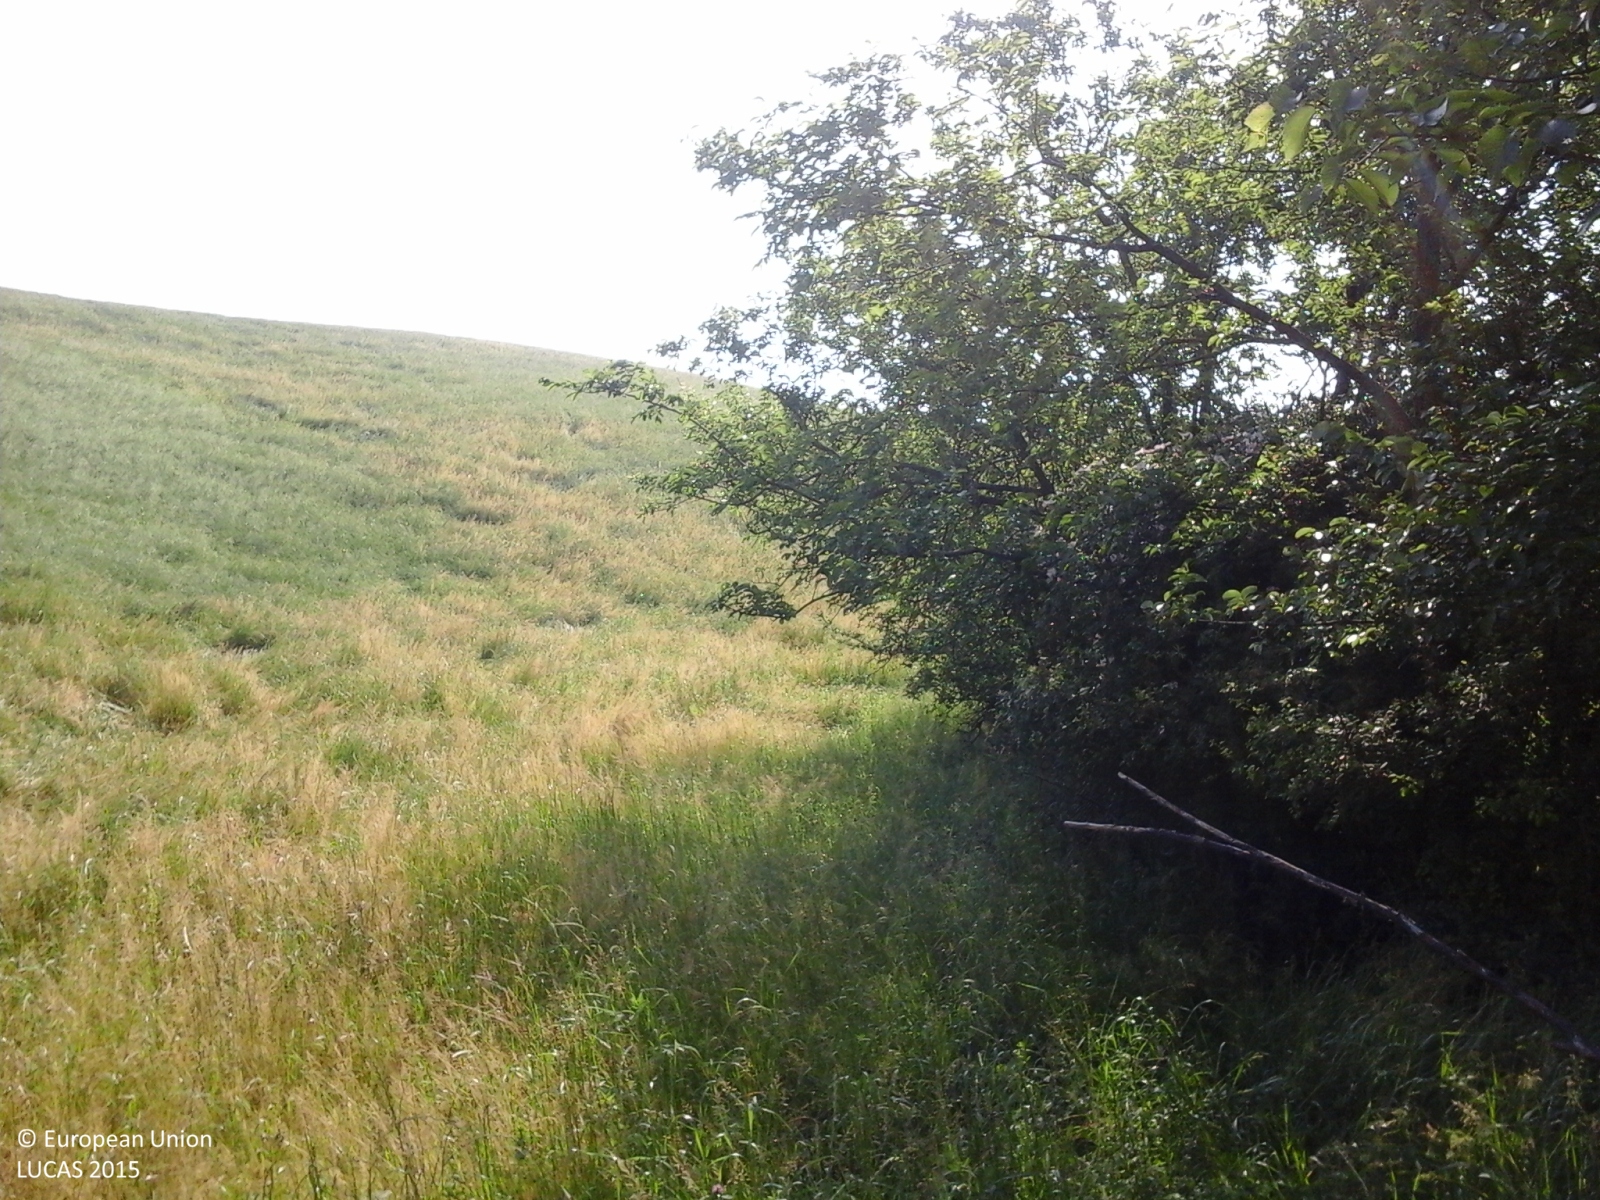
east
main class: Grassland
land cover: Grassland without tree/shrub cover
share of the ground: > 75 %
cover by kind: herbaceous plants 100 %
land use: Agriculture (excluding fallow land and kitchen gardens)
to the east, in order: Grassland without tree/shrub cover; Fences; Shrubland with sparse tree cover; Grassland without tree/shrub cover
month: May
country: IT
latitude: 44.6751
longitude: 10.1133
